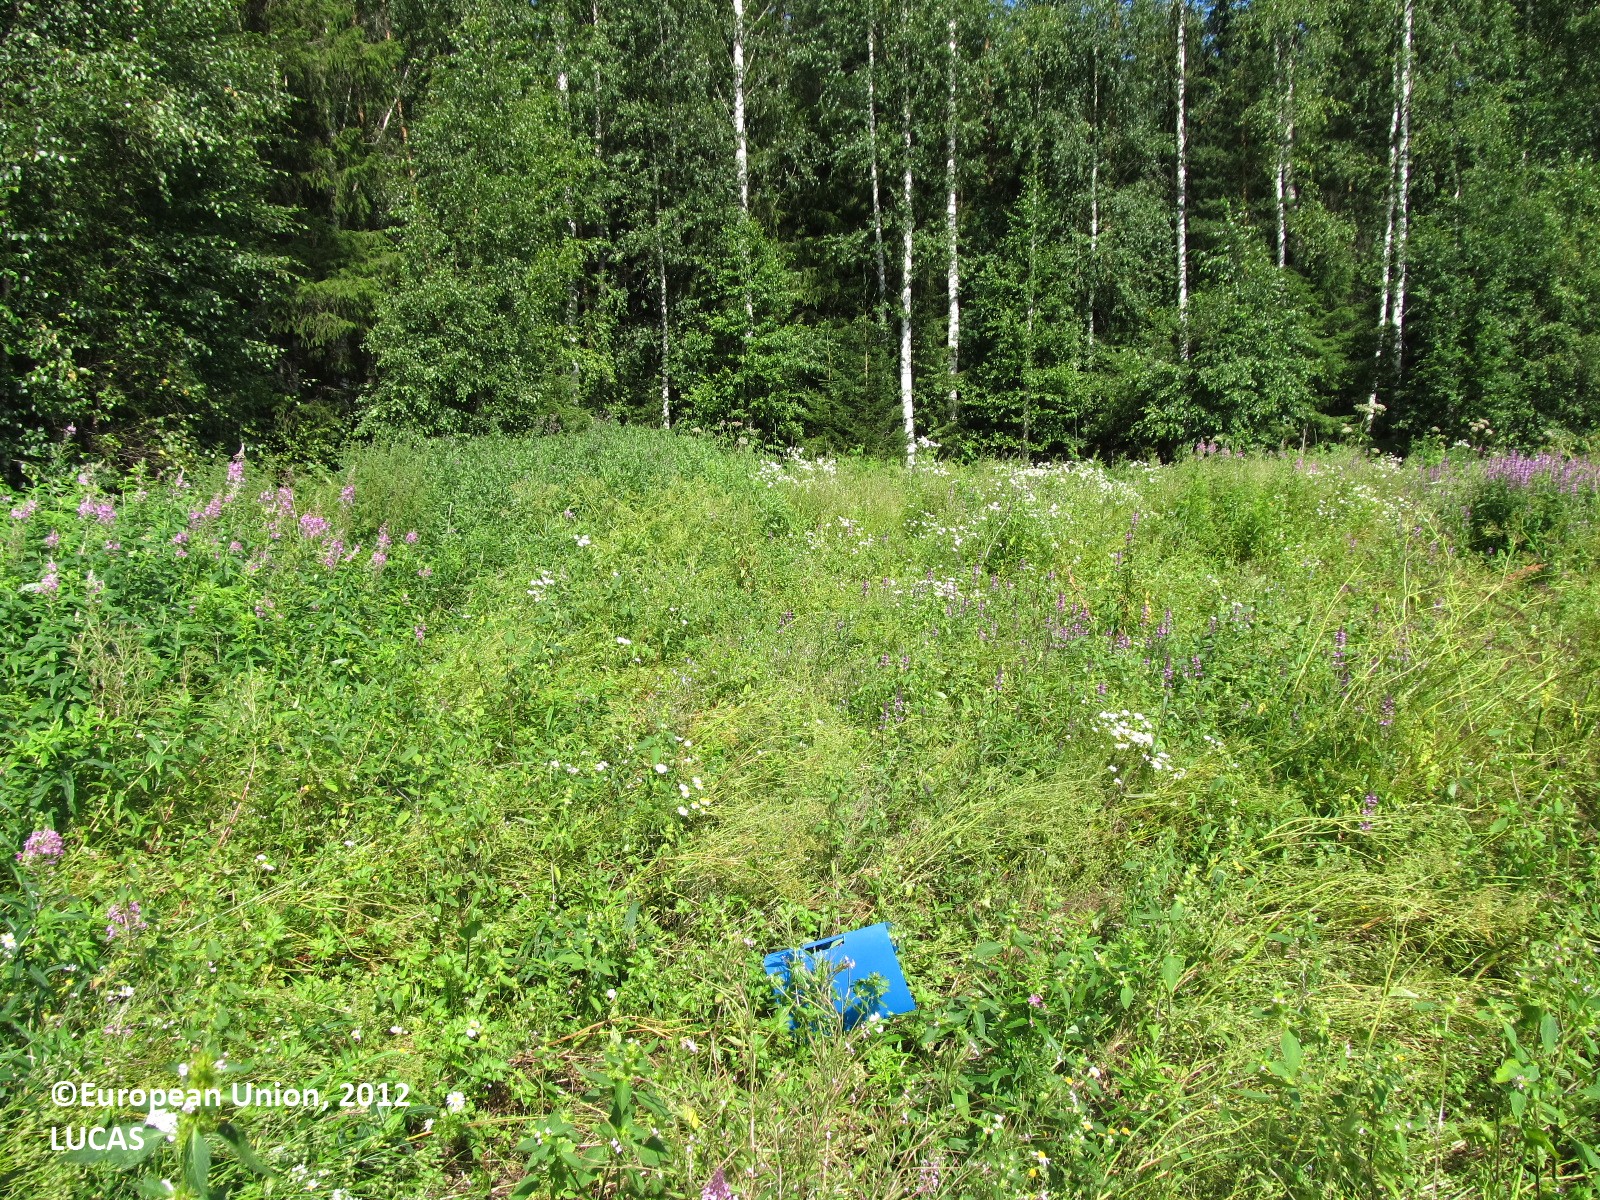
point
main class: Grassland
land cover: Grassland without tree/shrub cover
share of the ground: > 75 %
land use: Fallow land
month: July
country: FI
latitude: 61.9300
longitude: 28.0806
